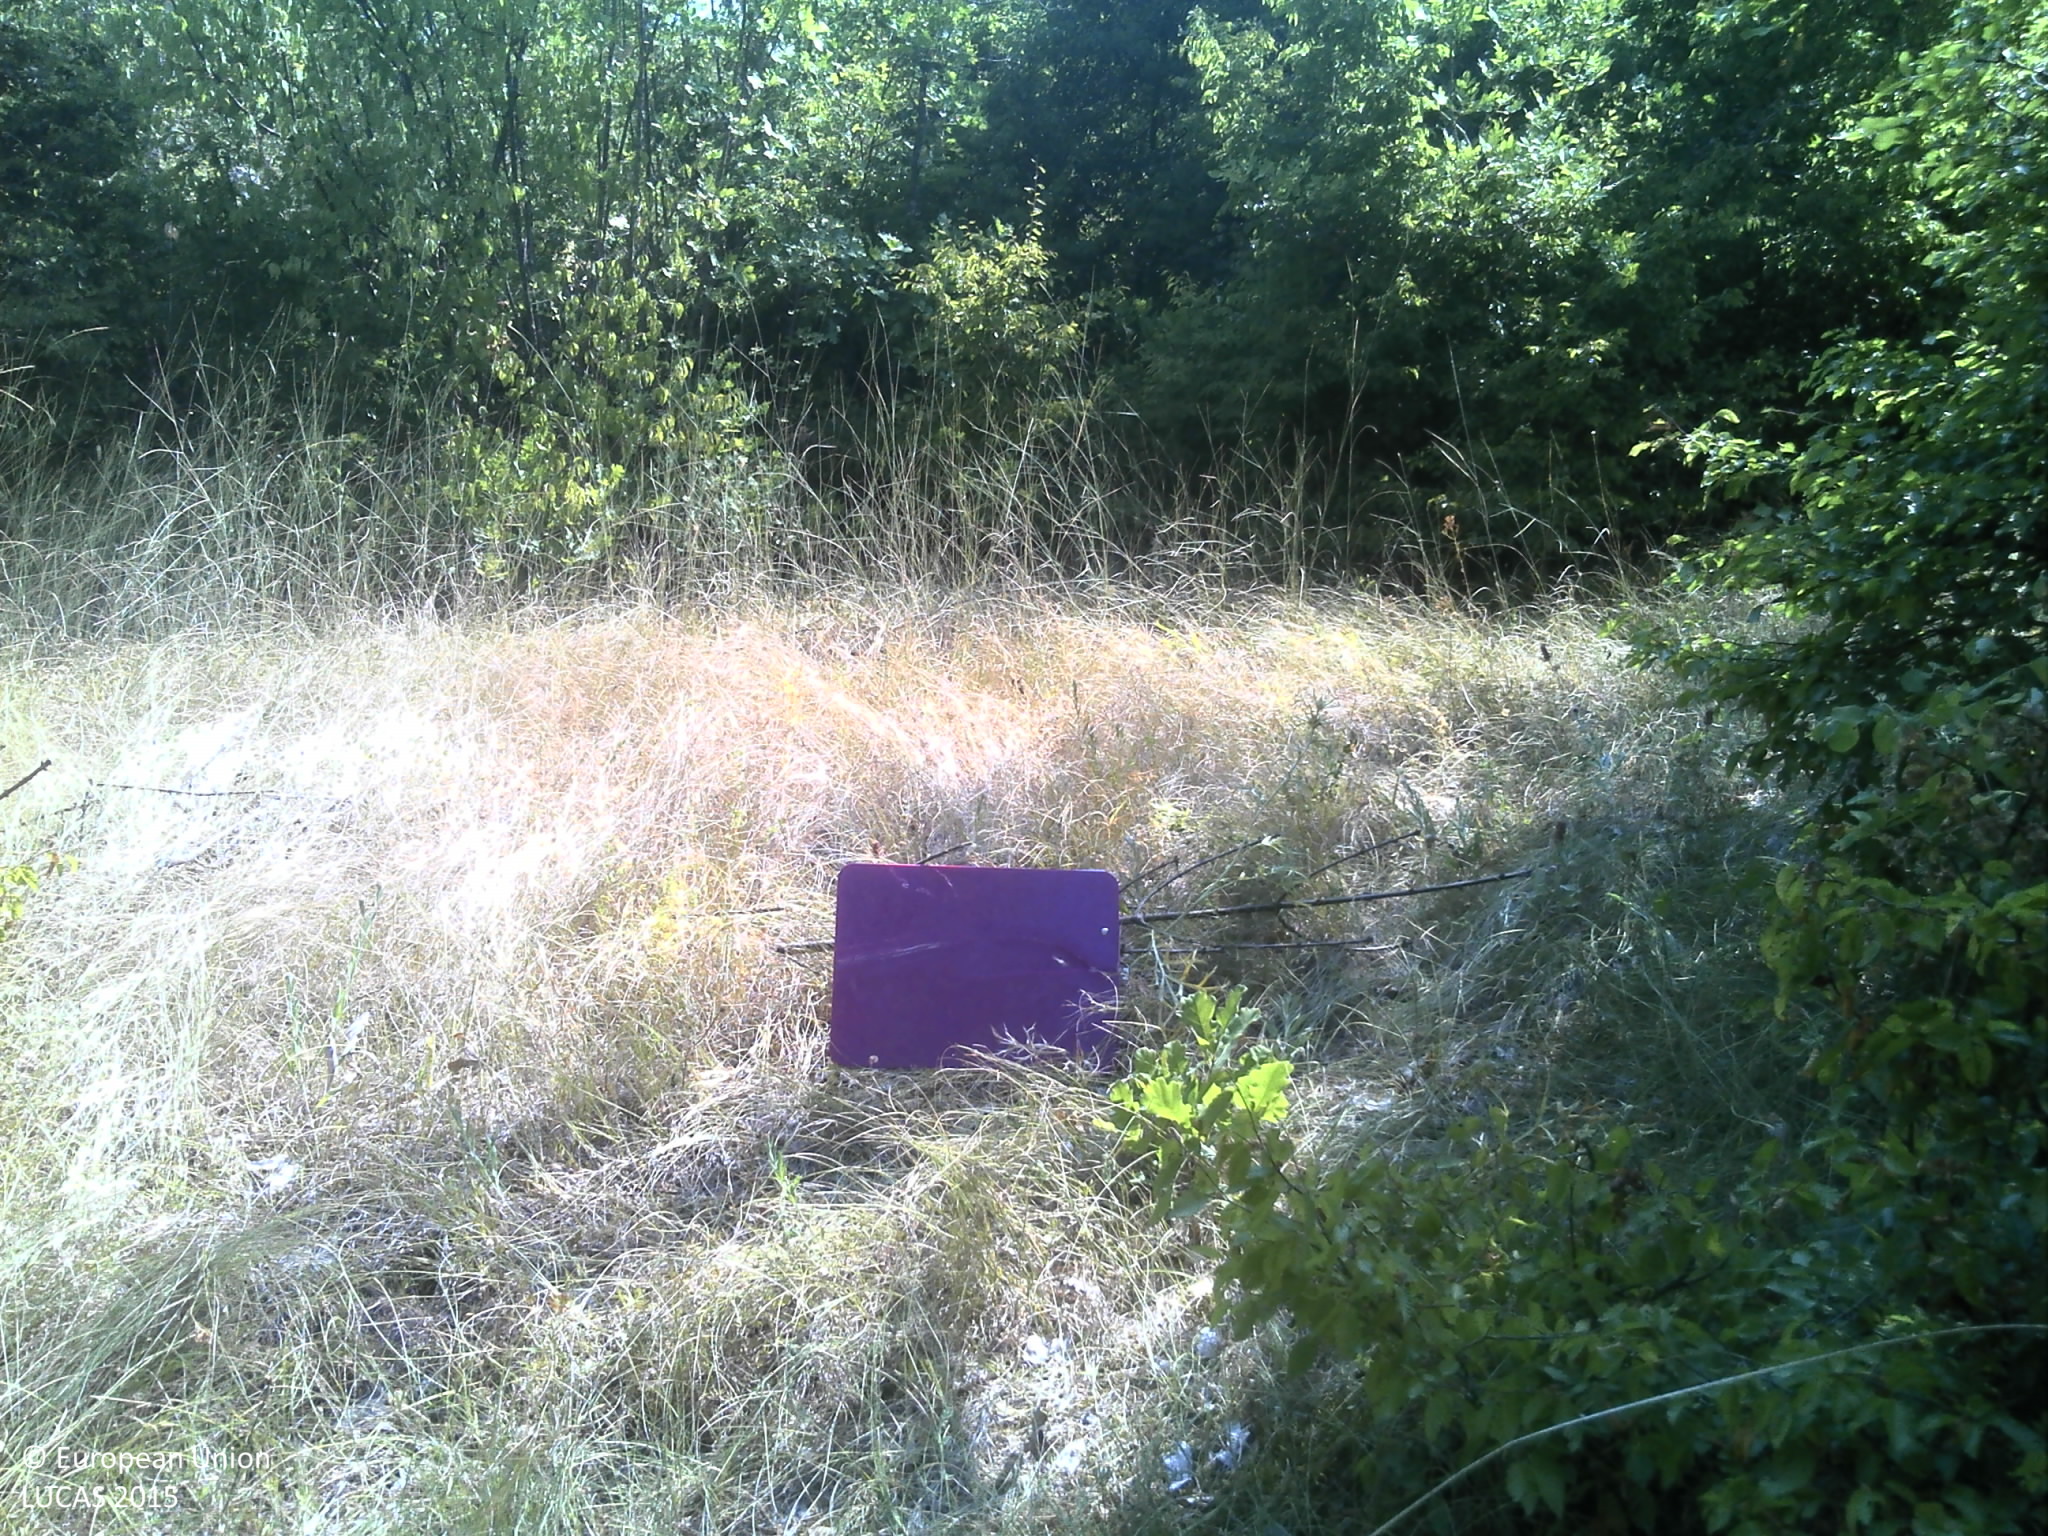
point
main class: Woodland
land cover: Broadleaved woodland
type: thermophilous deciduous forest
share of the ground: > 75 %
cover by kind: broadleaved forest trees 50 %, shrubs 35 %, herbaceous plants 10 %, consolidated bare surface 5 %
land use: Semi-natural and natural areas not in use
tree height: > 5 m
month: July
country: HR
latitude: 43.3537
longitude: 17.2585
